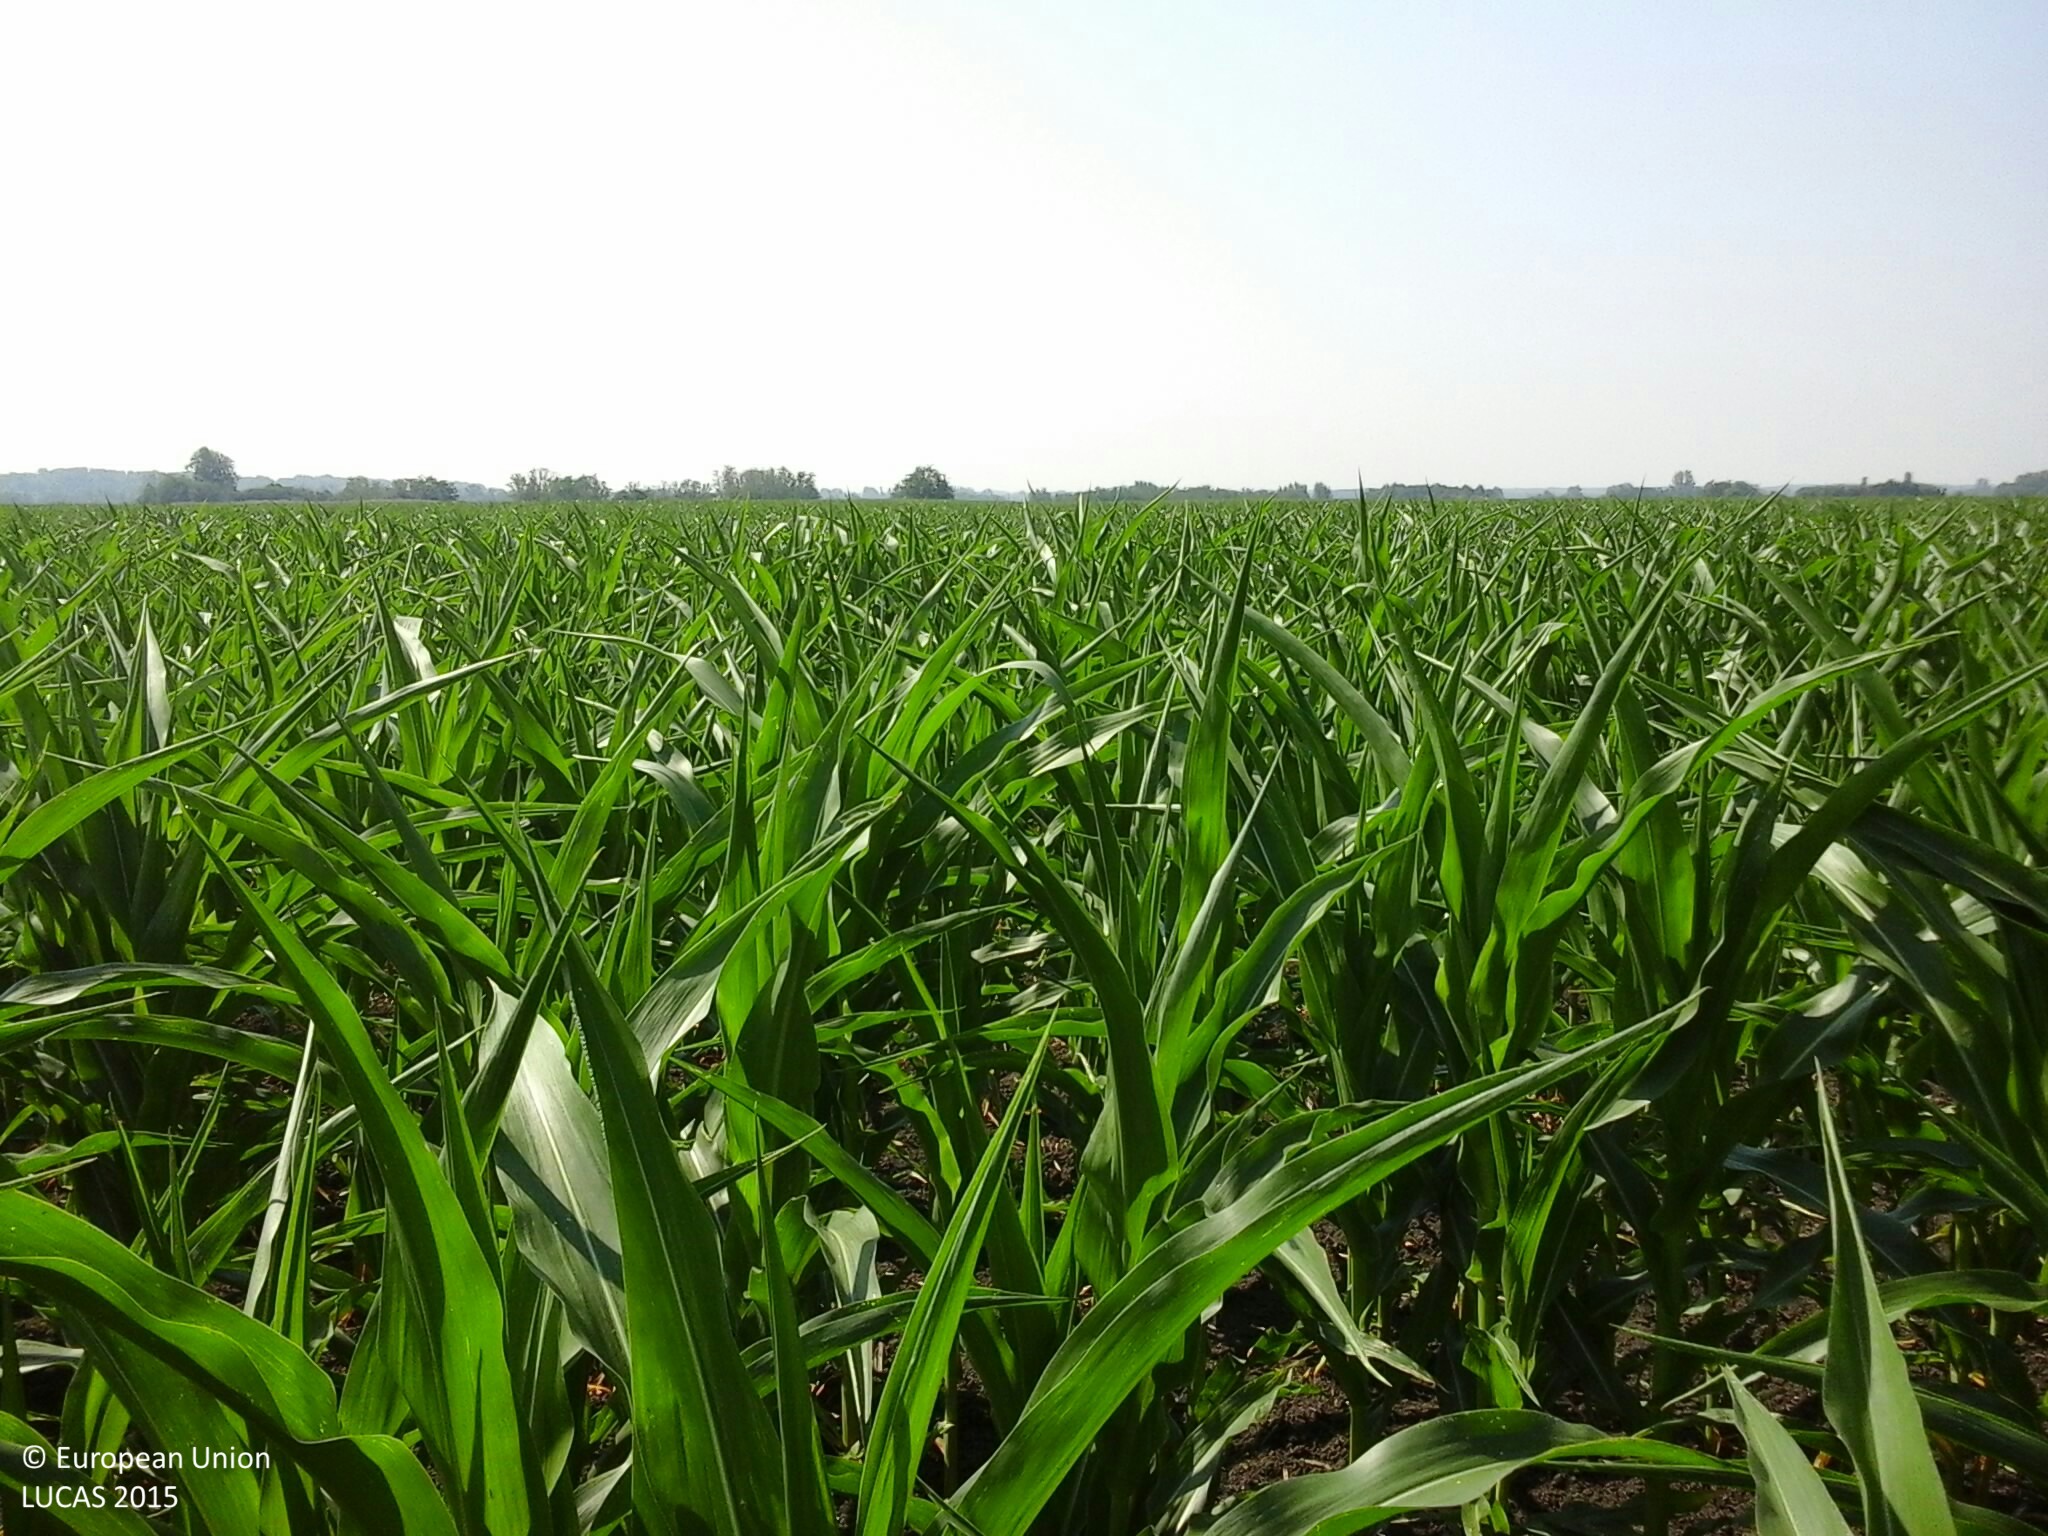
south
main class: Cropland
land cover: Maize
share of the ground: > 75 %
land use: Agriculture (excluding fallow land and kitchen gardens)
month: July
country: HU
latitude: 46.7722
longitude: 20.1737
